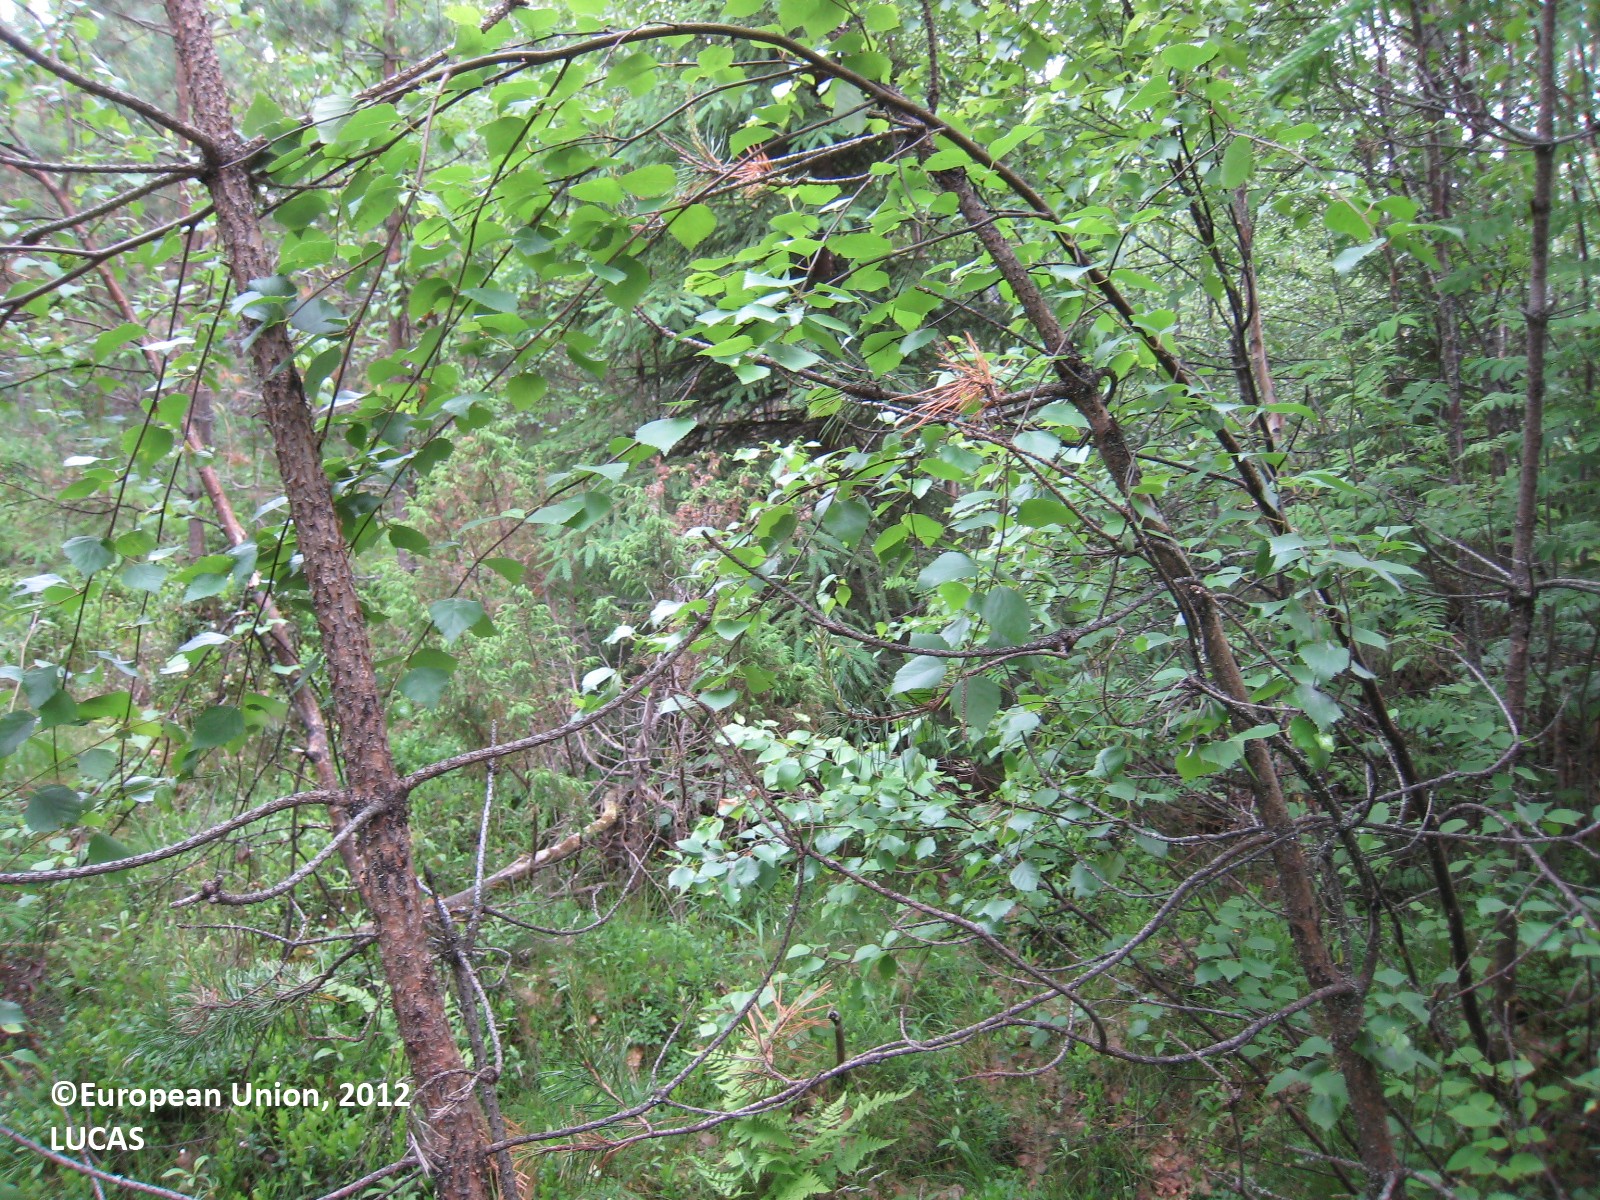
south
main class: Woodland
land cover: Other mixed woodland
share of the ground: > 75 %
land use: Forestry
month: June
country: FI
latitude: 62.1044
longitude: 26.2870
